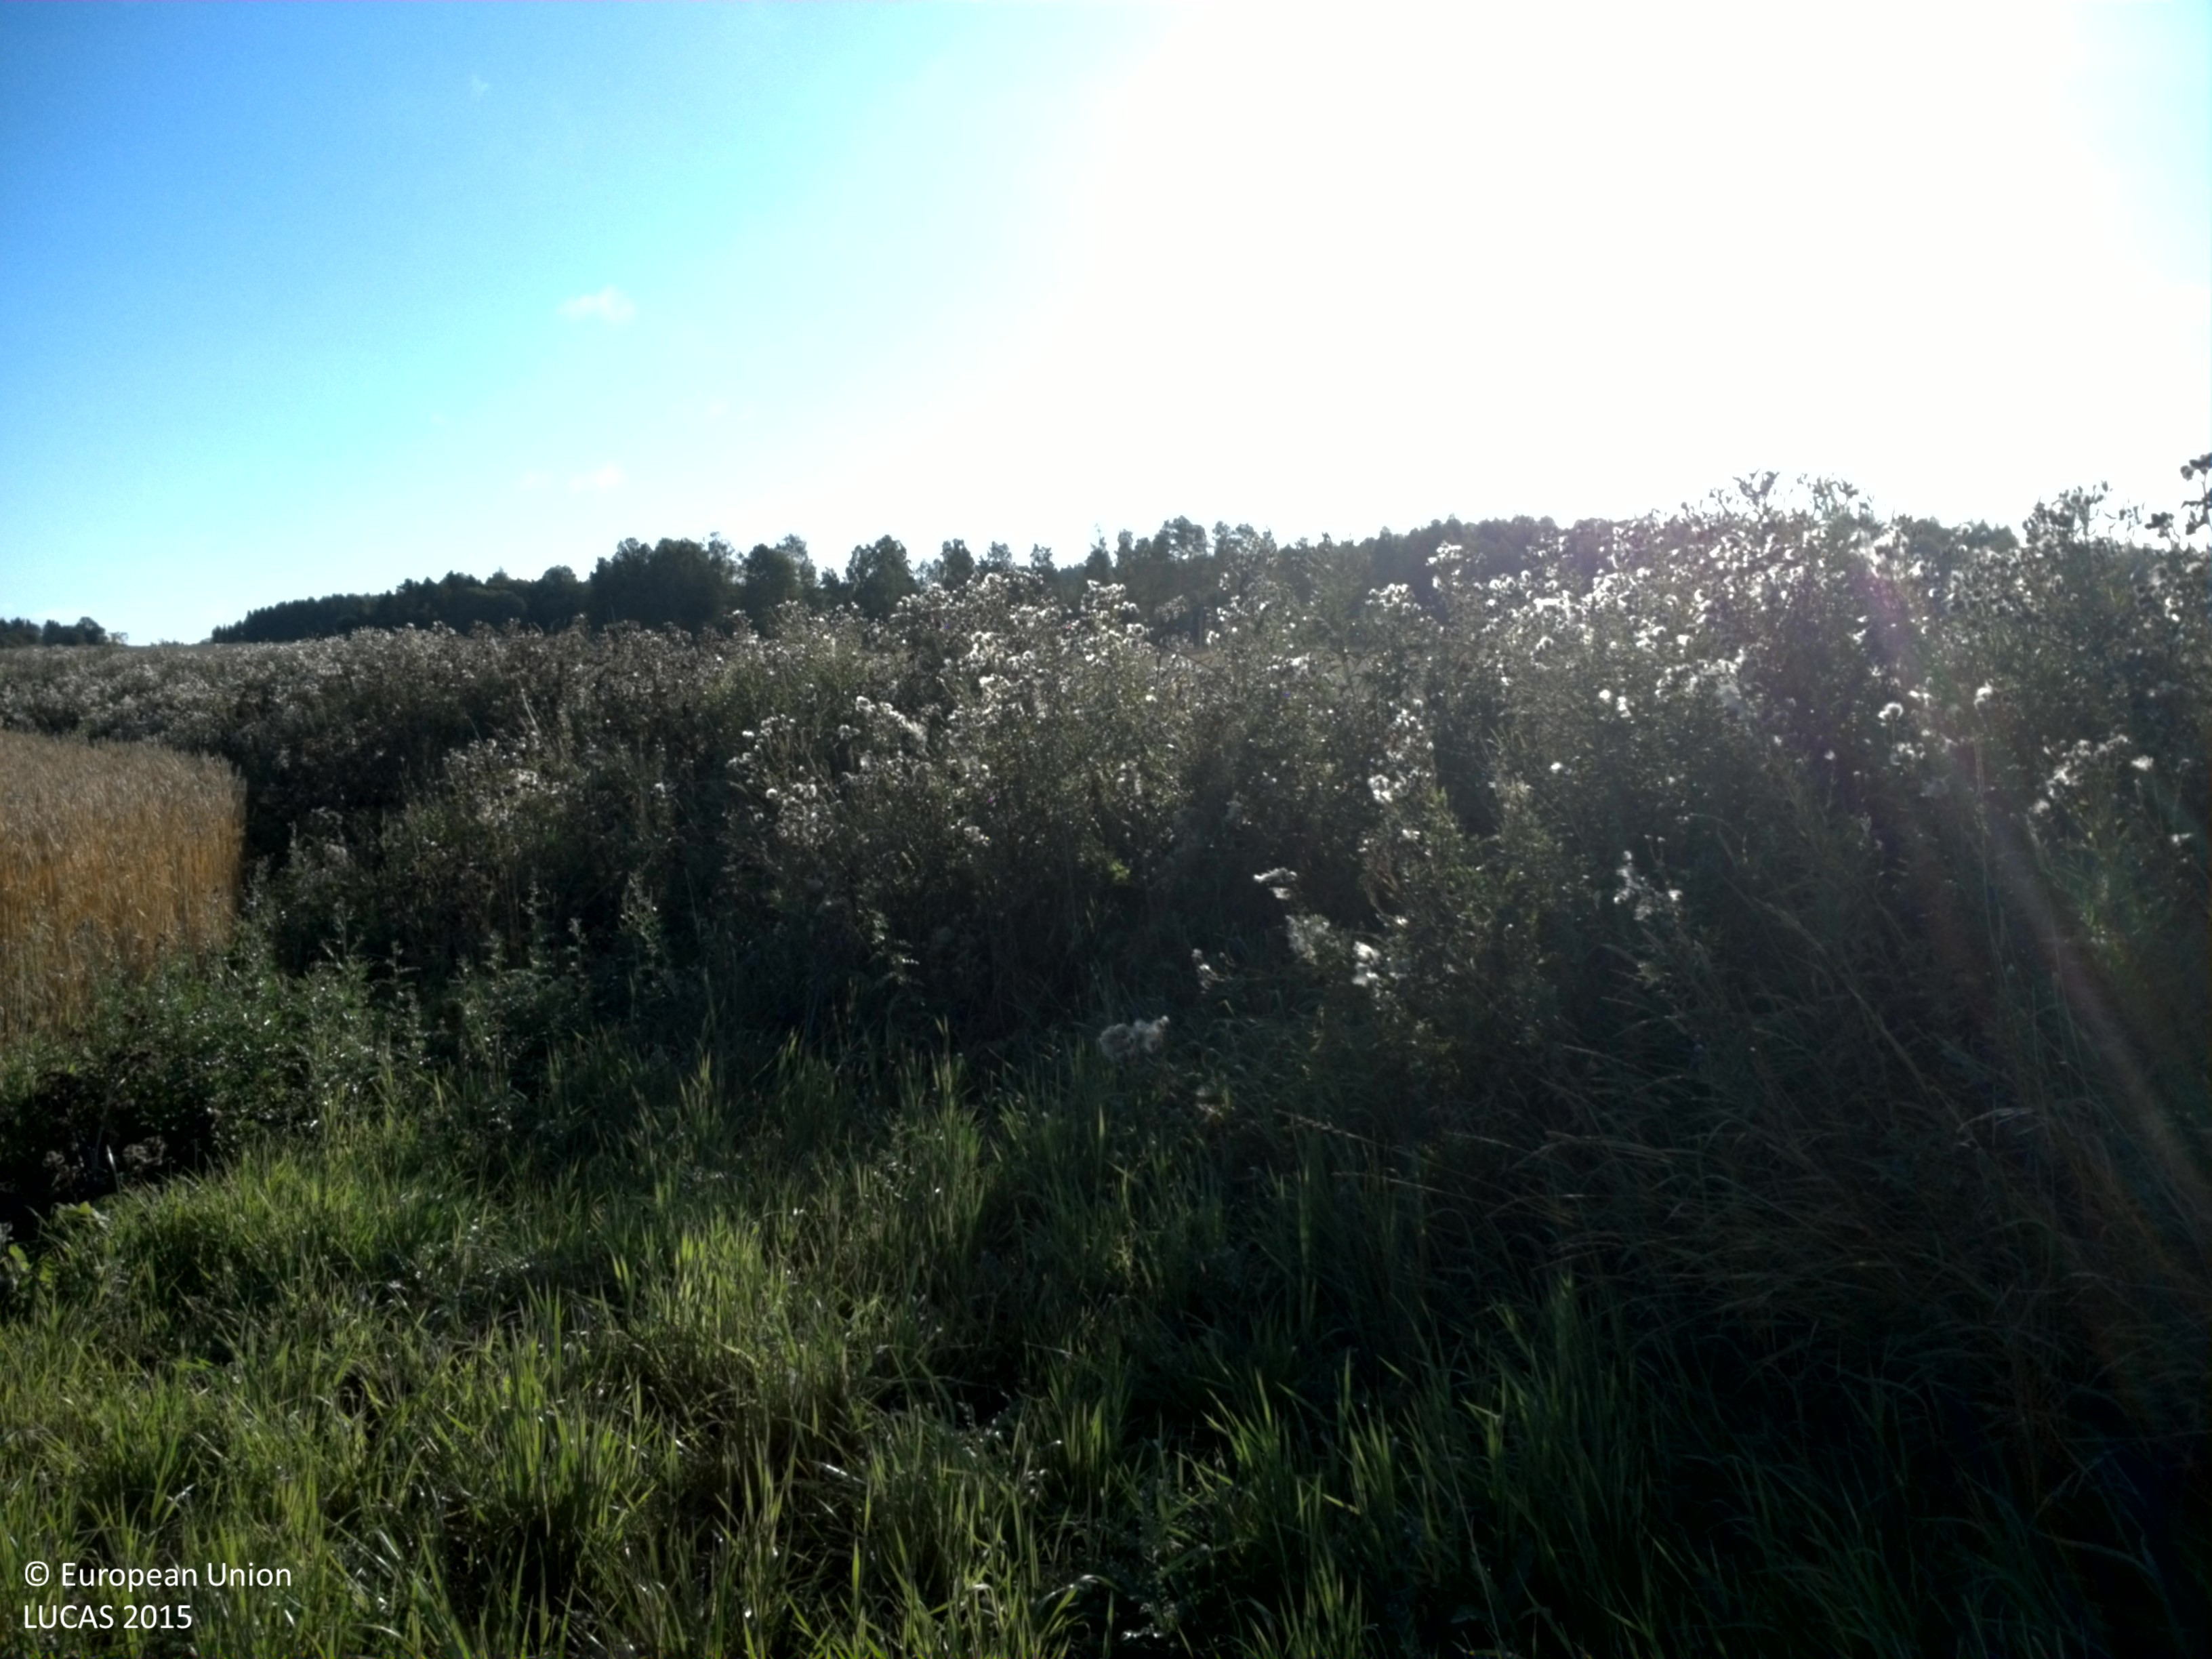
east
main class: Grassland
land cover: Grassland without tree/shrub cover
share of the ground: > 75 %
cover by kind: herbaceous plants 100 %
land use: Agriculture (excluding fallow land and kitchen gardens)
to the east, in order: Grassland without tree/shrub cover; Spontaneously vegetated surfaces; Ditches and canals; Common wheat; Ditches and canals; Common wheat
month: August
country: SE
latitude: 59.6881
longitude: 17.2233
